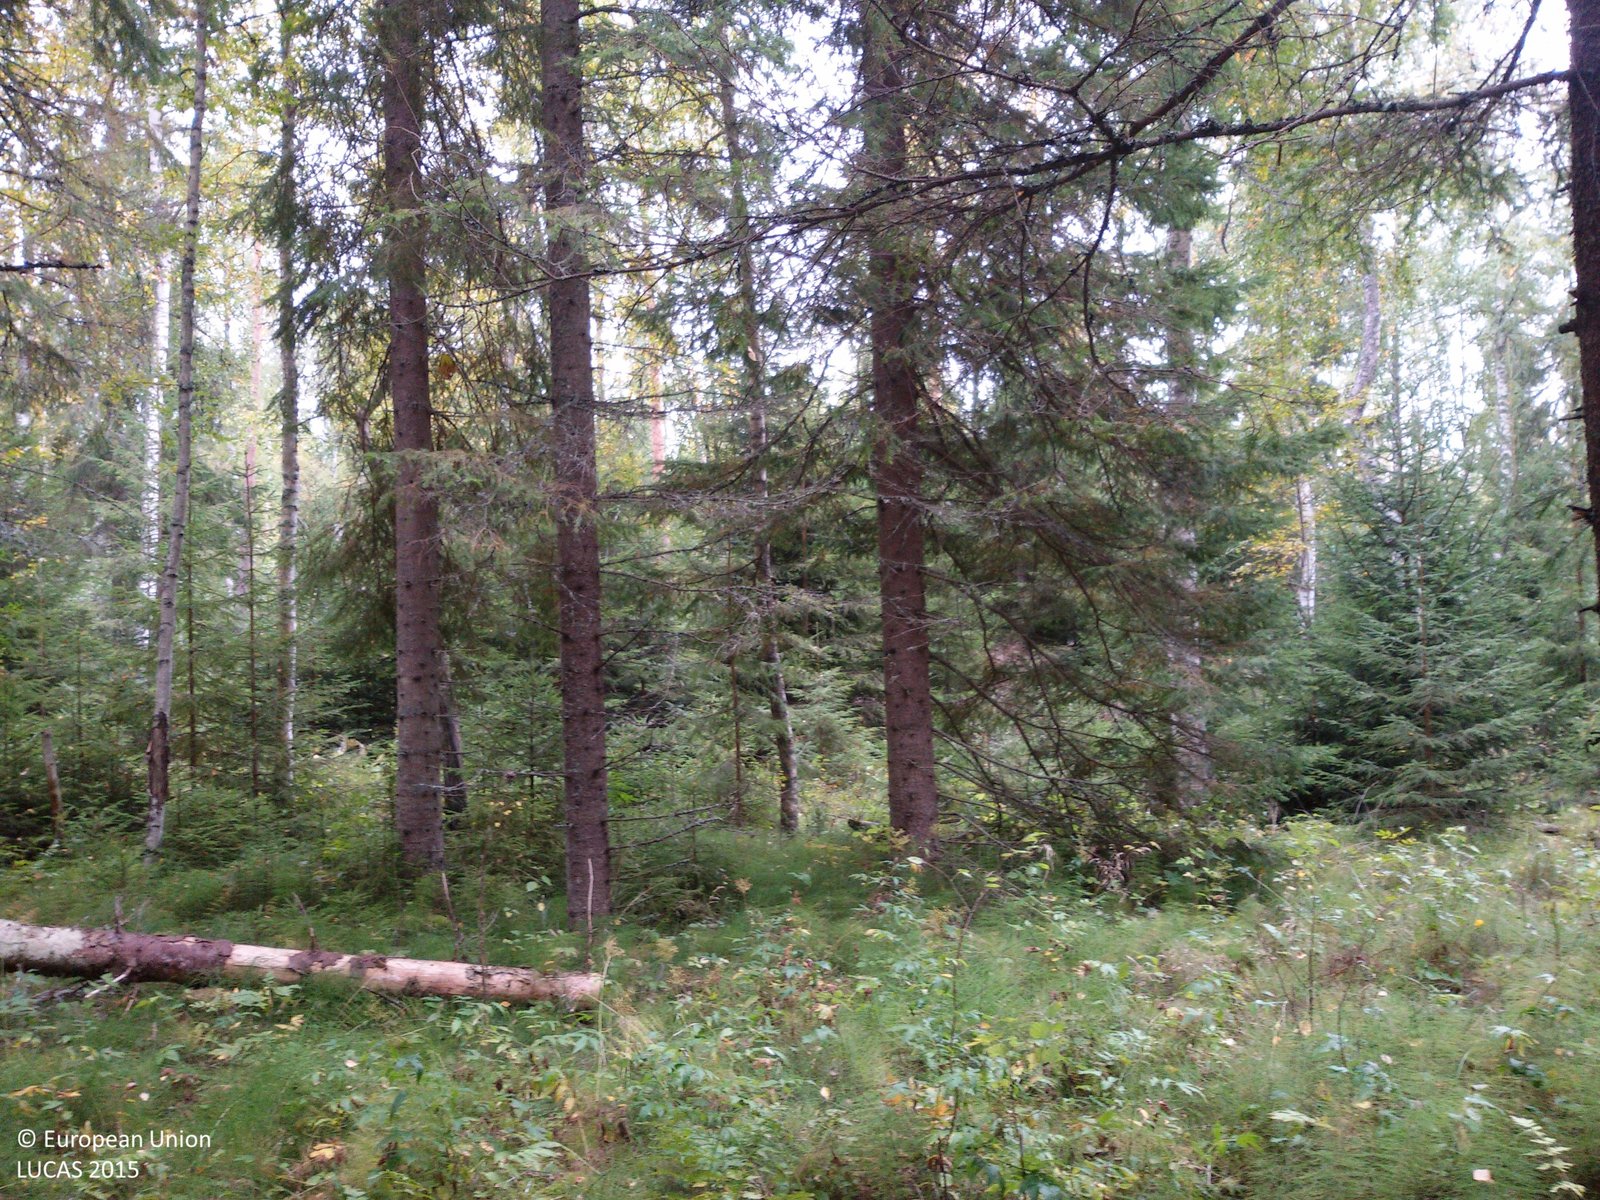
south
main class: Woodland
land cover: Spruce dominated mixed woodland
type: boreal forest
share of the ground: 50 - 75 %
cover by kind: coniferous forest trees 40 %, broadleaved forest trees 30 %, herbaceous plants 15 %, lichens and mosses 10 %, shrubs 5 %
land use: Forestry
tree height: > 5 m
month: September
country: SE
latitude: 60.7660
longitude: 14.8147
